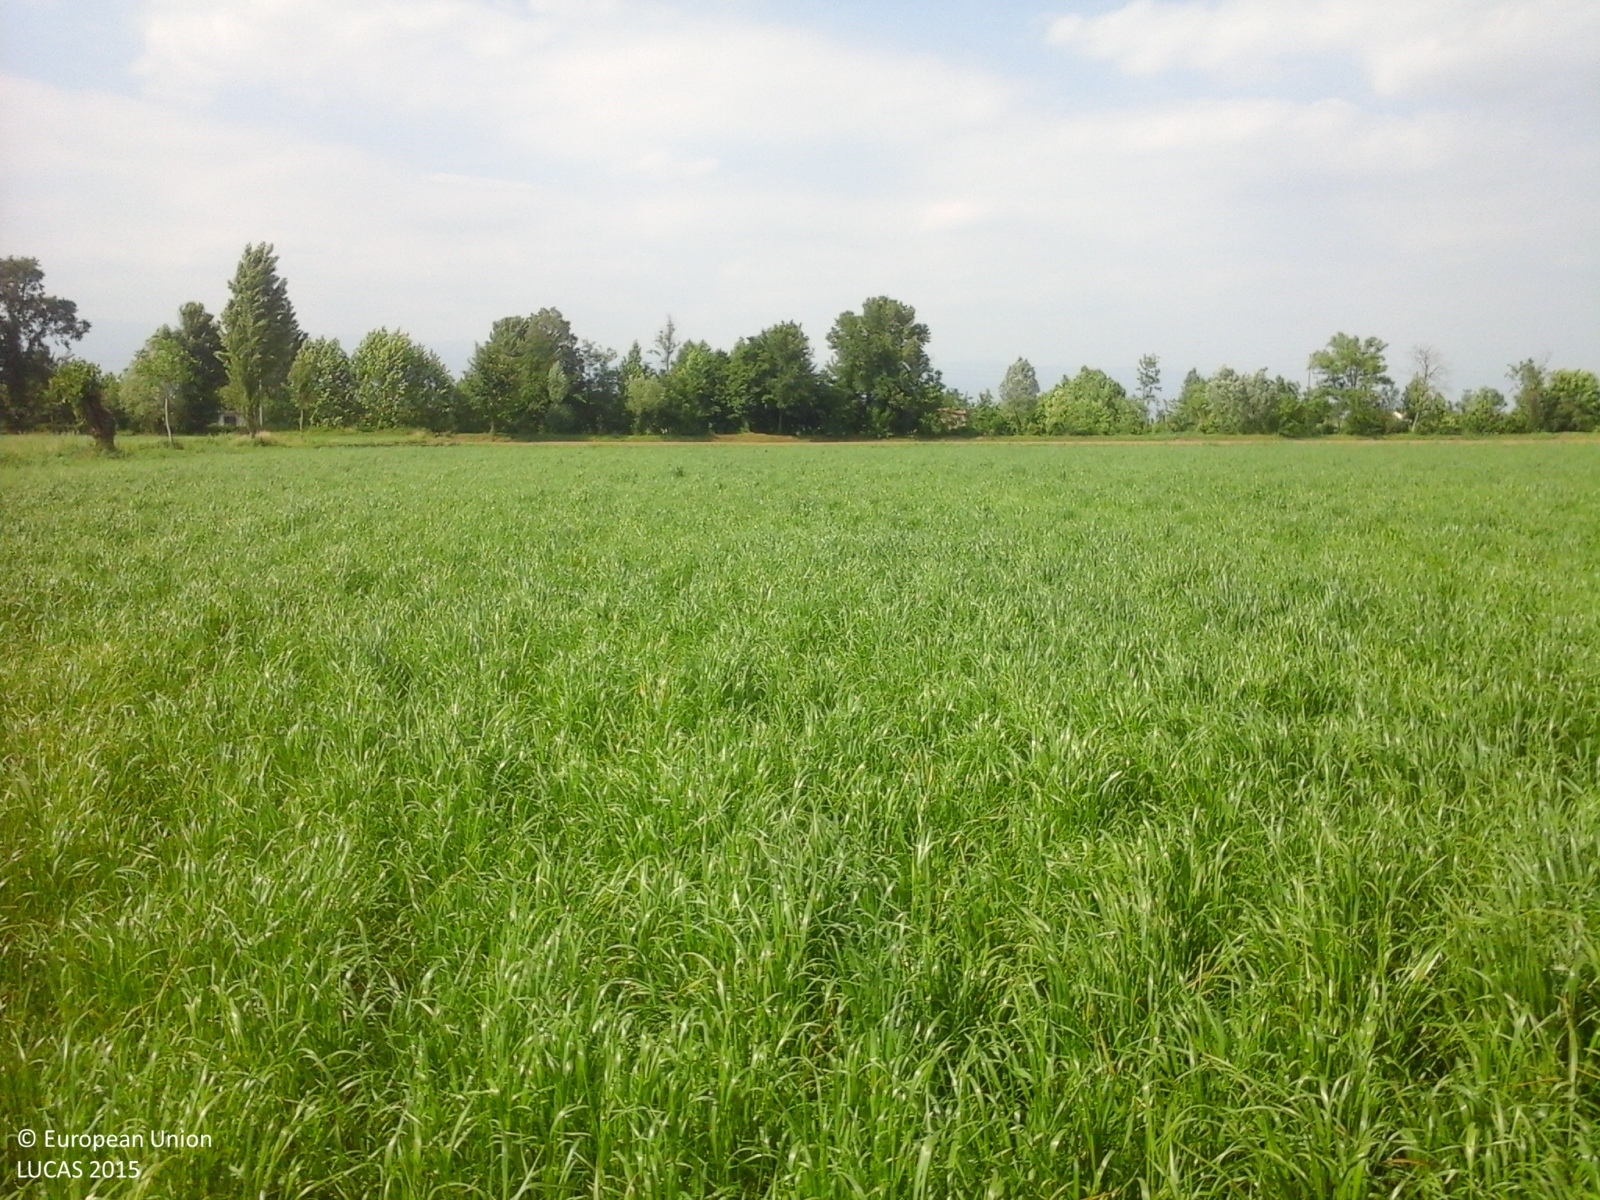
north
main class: Grassland
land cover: Spontaneously vegetated surfaces
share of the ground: > 75 %
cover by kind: herbaceous plants 100 %
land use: Agriculture (excluding fallow land and kitchen gardens)
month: May
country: IT
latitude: 45.6012
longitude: 11.5488
